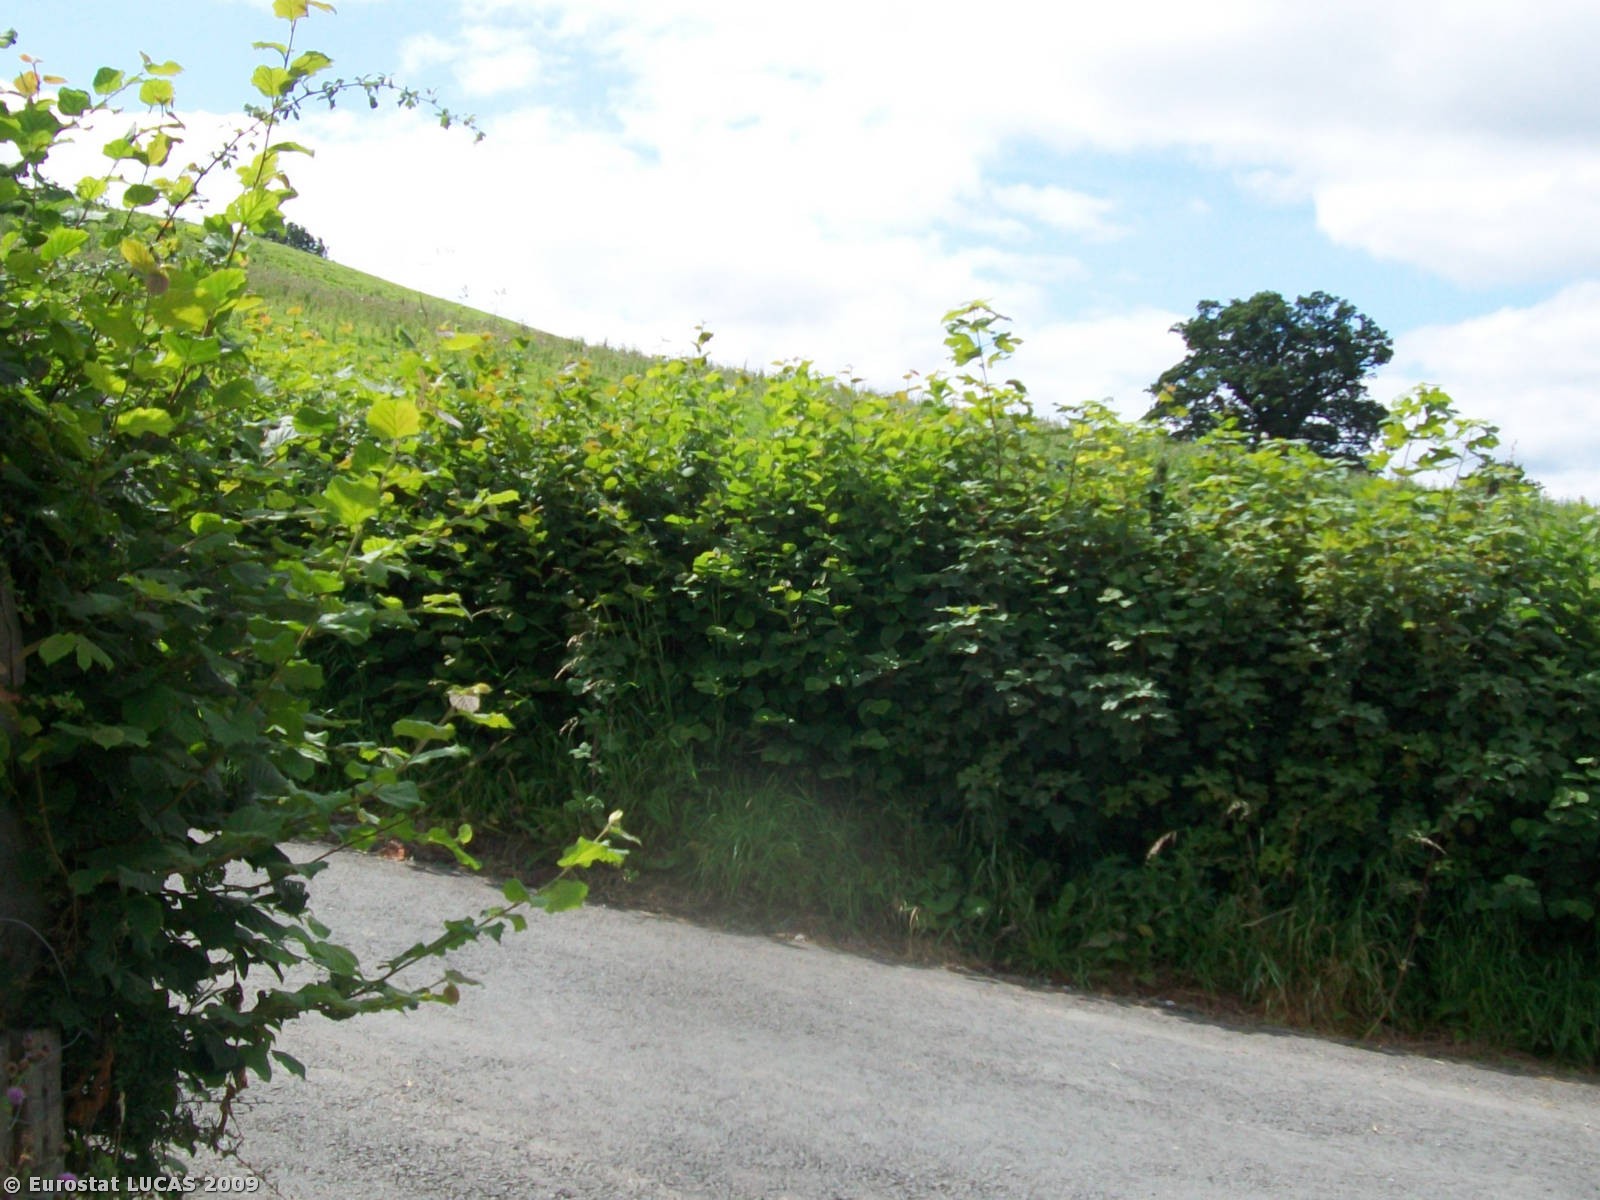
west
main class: Grassland
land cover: Grassland without tree/shrub cover
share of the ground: > 75 %
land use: Agriculture (excluding fallow land and kitchen gardens)
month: August
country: GB
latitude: 52.4973
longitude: -3.3231
